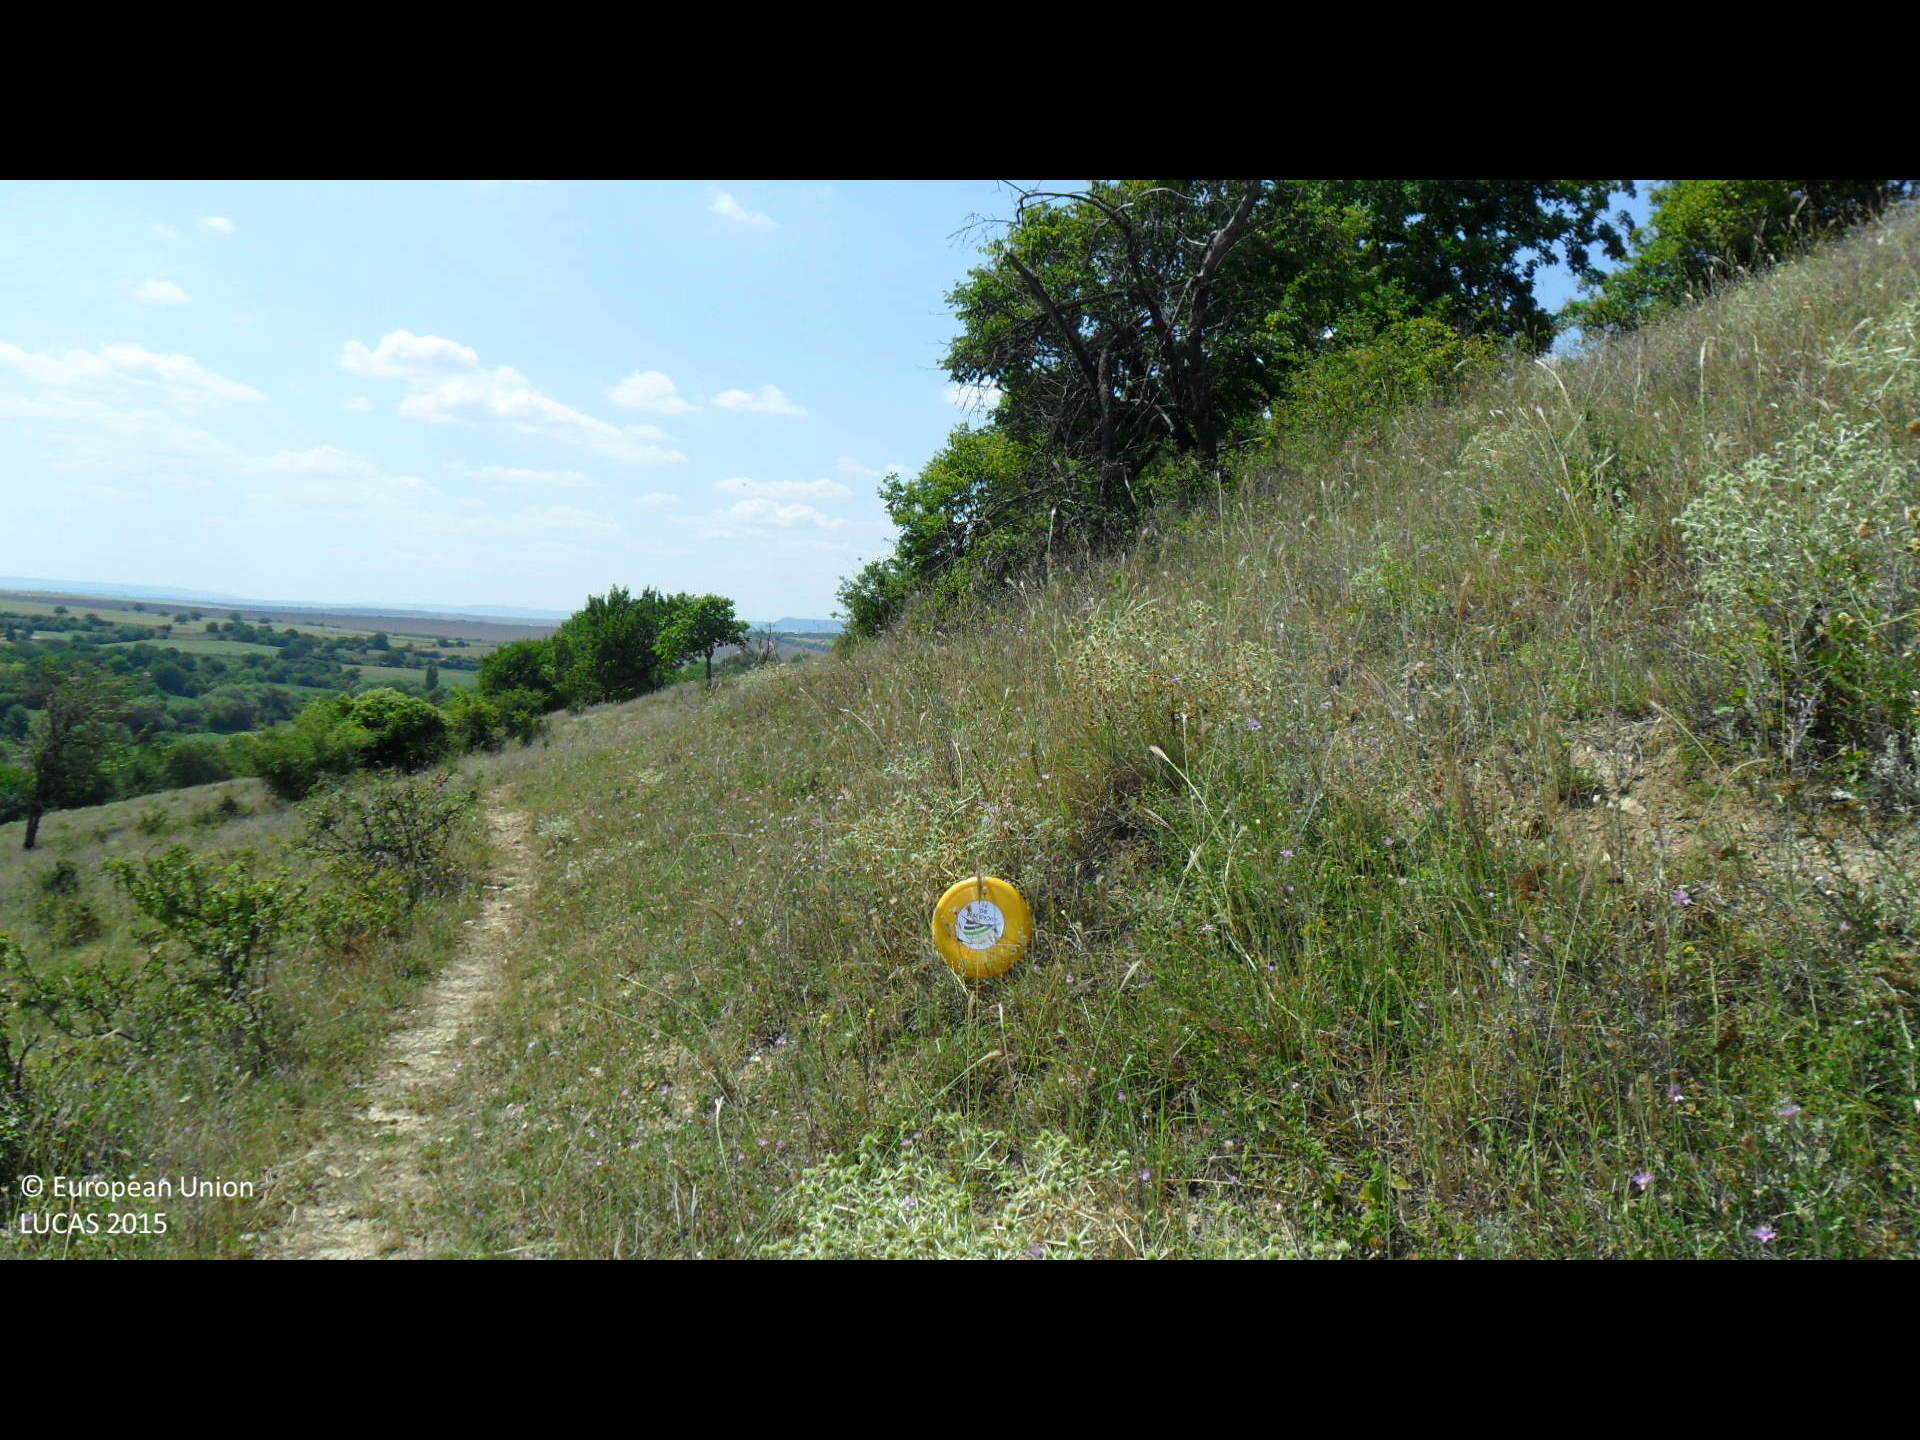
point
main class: Grassland
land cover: Grassland with sparse tree/shrub cover
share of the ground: > 75 %
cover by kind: herbaceous plants 90 %, broadleaved forest trees 5 %, shrubs 5 %
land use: Agriculture (excluding fallow land and kitchen gardens)
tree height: < 5 m
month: August
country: BG
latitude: 43.4357
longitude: 26.4221
